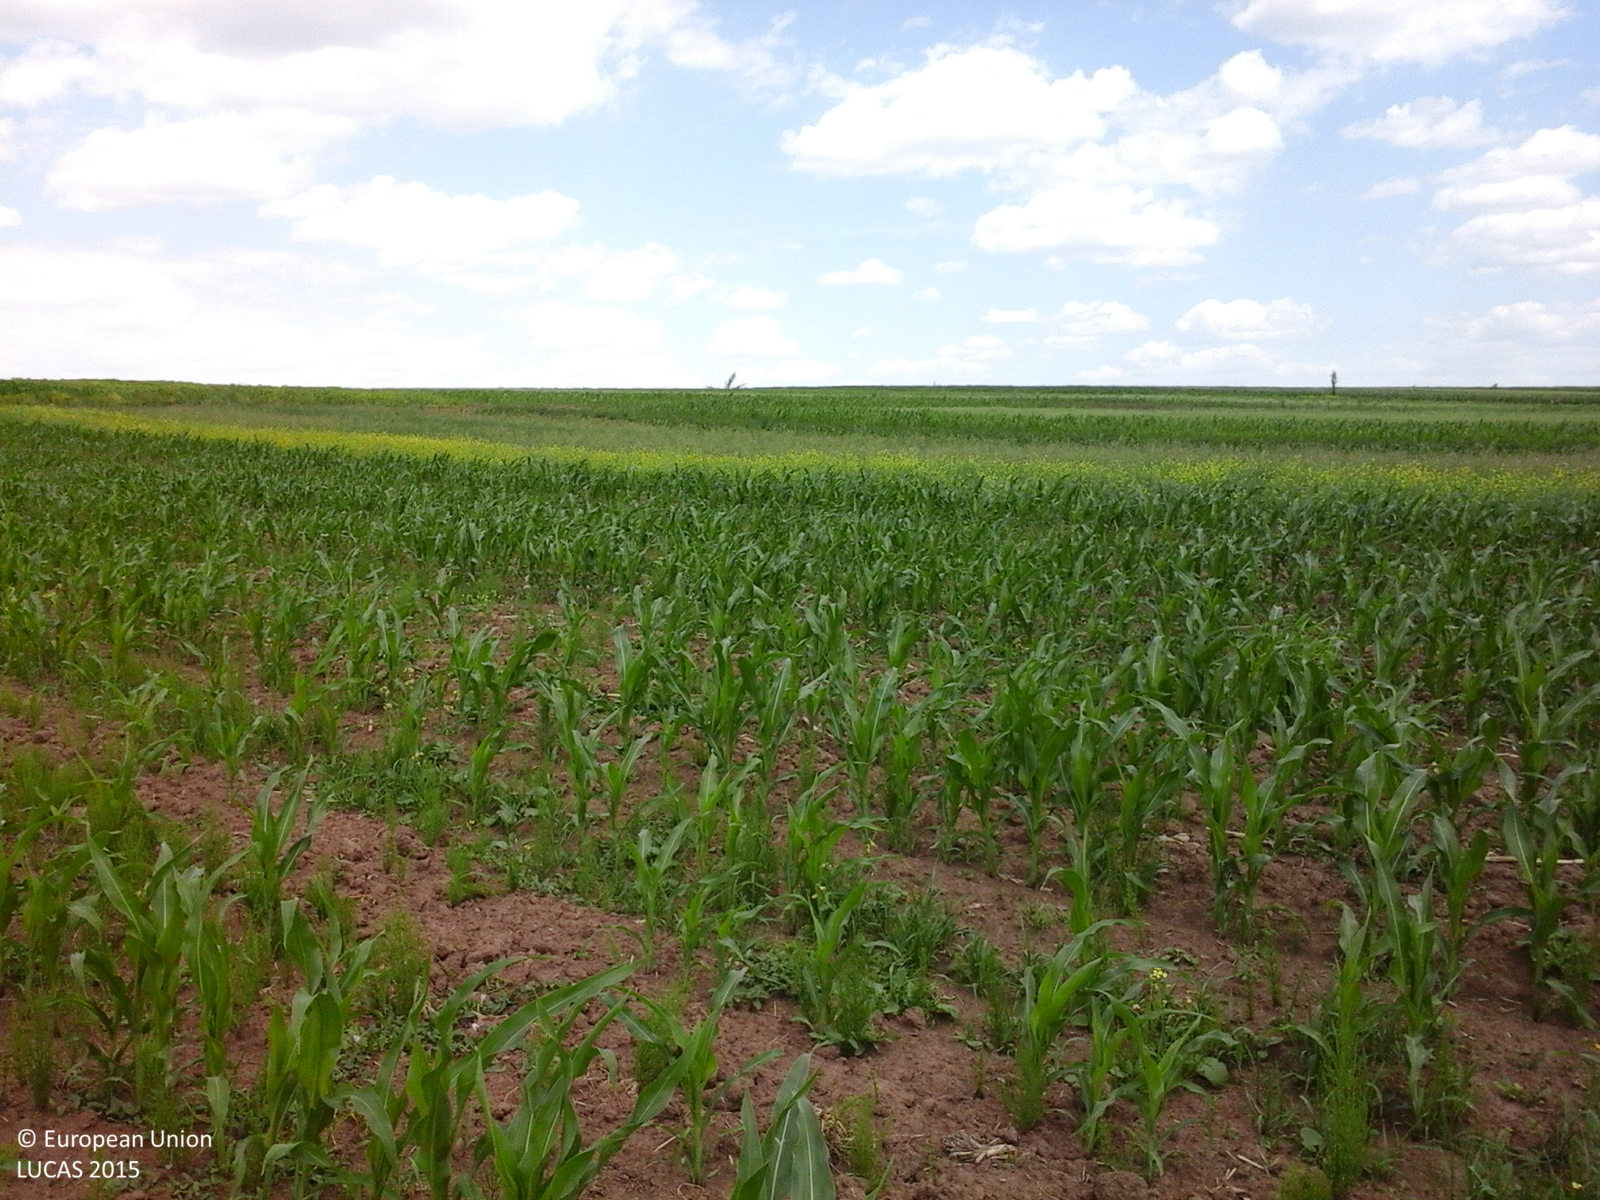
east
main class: Cropland
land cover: Maize
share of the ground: 50 - 75 %
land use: Agriculture (excluding fallow land and kitchen gardens)
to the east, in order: Maize; Grassland without tree/shrub cover; Maize; Potatoes; Maize; Common wheat; Lucerne; Maize; Grass margins; Tracks; Grass margins; Common wheat; Maize; Grassland without tree/shrub cover; Lucerne; Maize; Other leguminous and mixtures for fodder; Maize; Oats; Maize; Common wheat
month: June
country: RO
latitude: 47.6325
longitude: 26.3624
